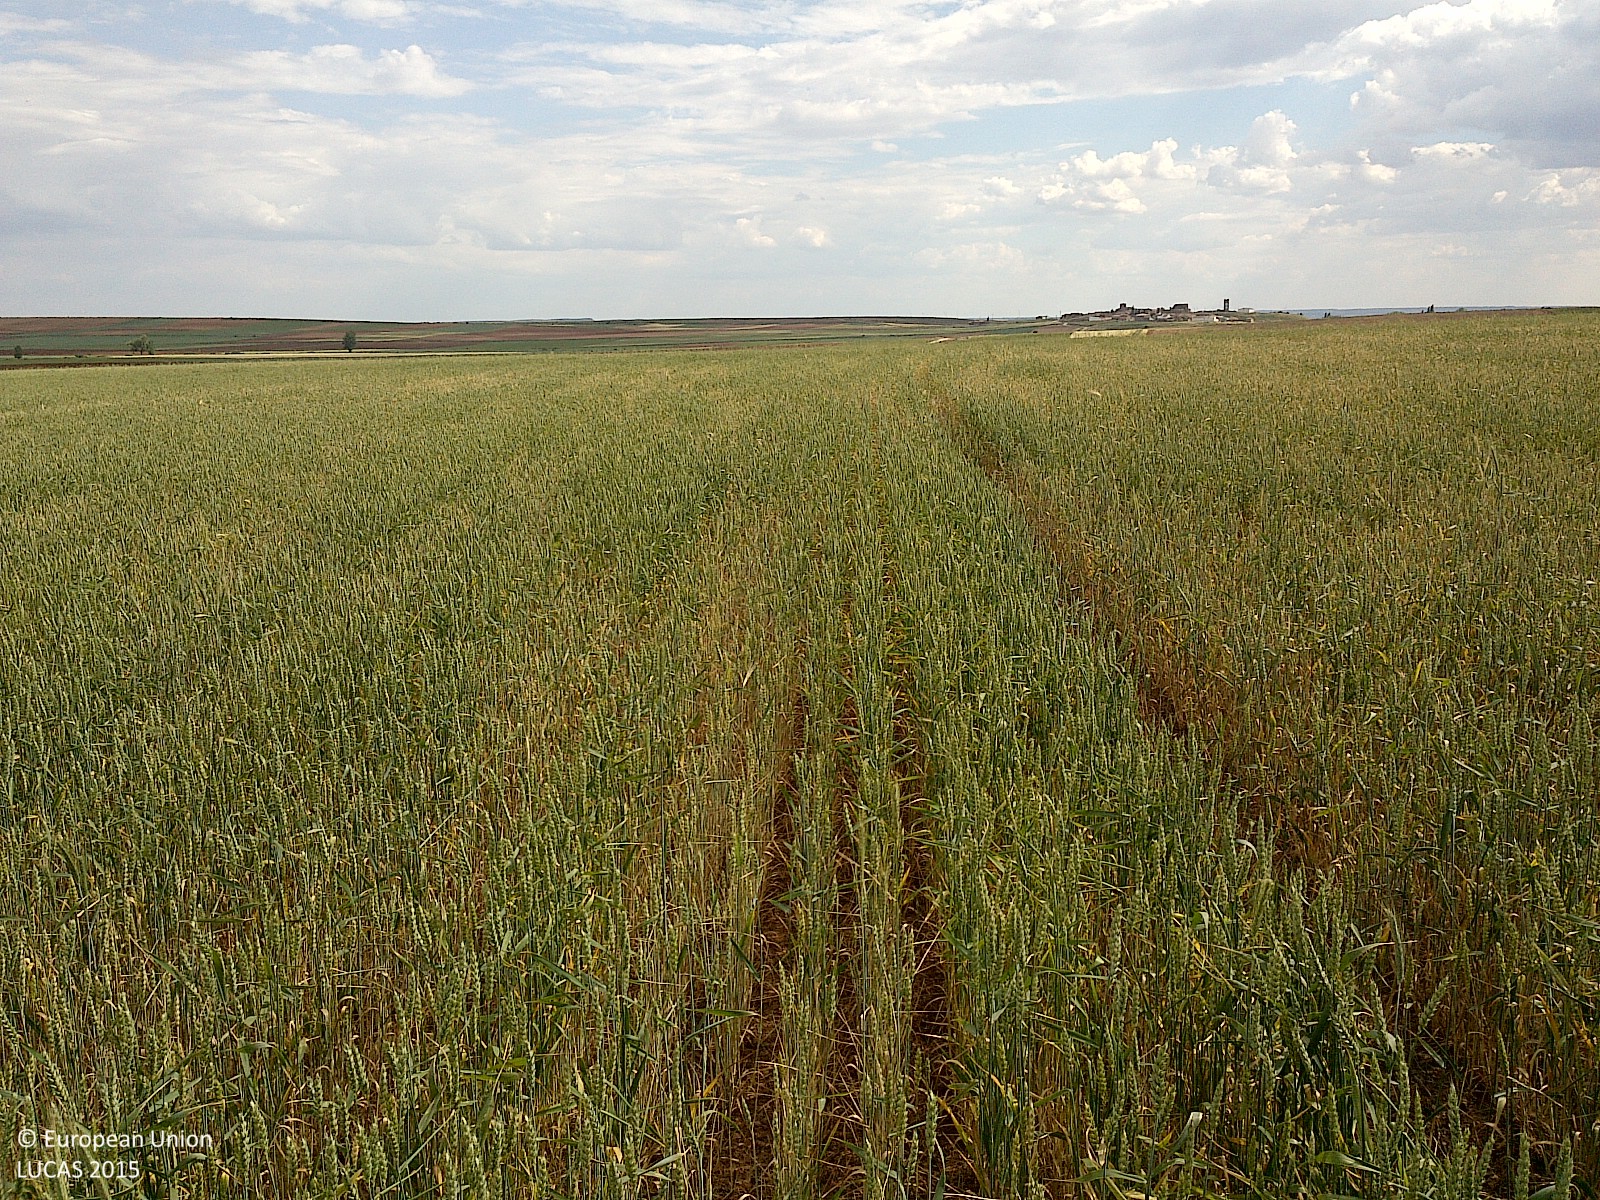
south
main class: Cropland
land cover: Common wheat
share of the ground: > 75 %
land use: Agriculture (excluding fallow land and kitchen gardens)
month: June
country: ES
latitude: 41.7295
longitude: -2.2131
